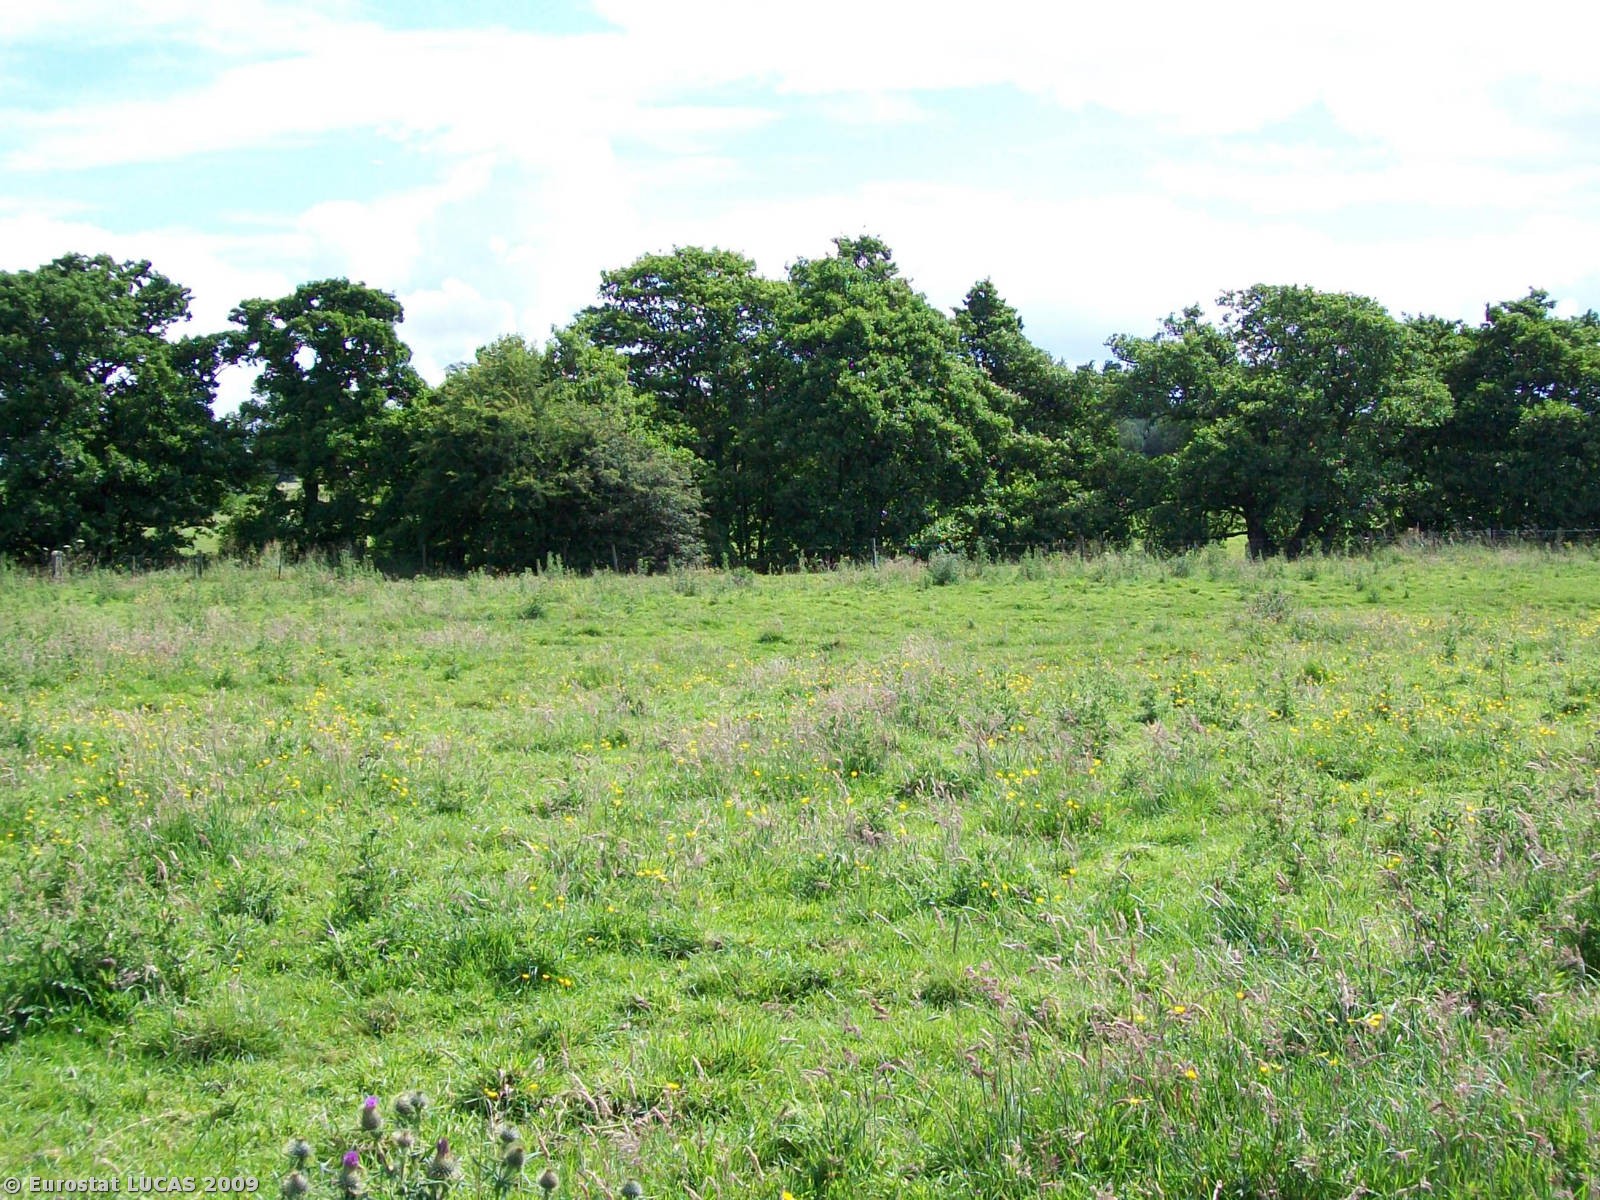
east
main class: Grassland
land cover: Grassland without tree/shrub cover
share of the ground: > 75 %
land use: Agriculture (excluding fallow land and kitchen gardens)
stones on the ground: < 10 %
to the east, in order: Grassland without tree/shrub cover; Inland running water; Fences; Inland running water; Broadleaved woodland; Grassland without tree/shrub cover; Broadleaved woodland
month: July
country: GB
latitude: 55.4002
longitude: -1.8468
